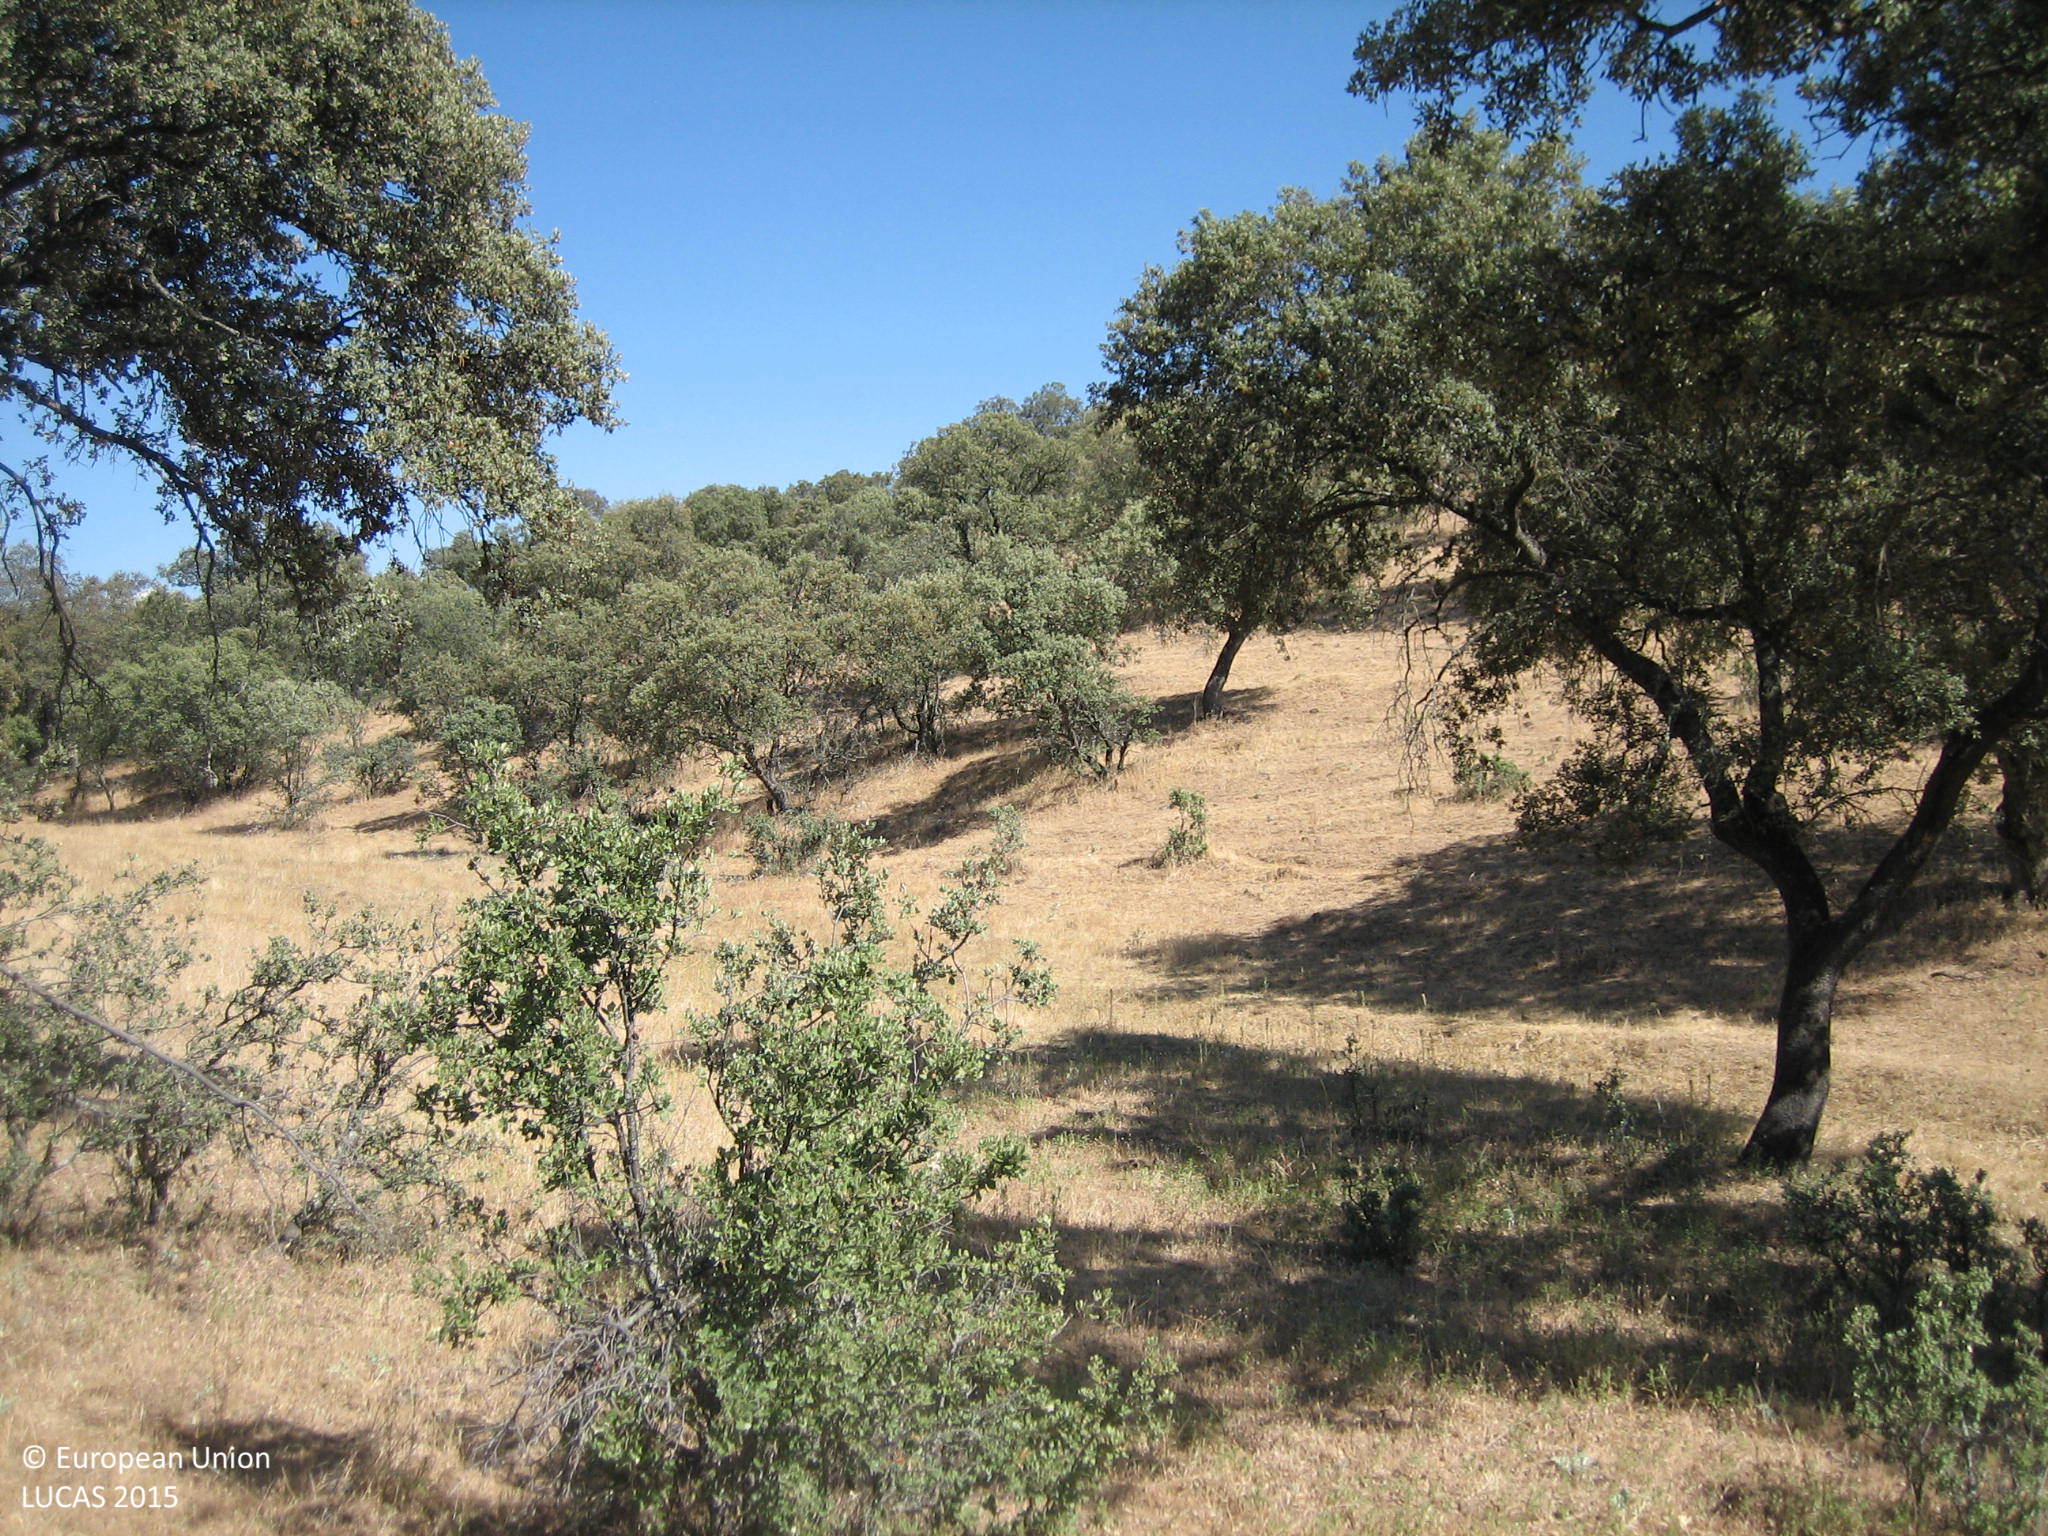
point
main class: Woodland
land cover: Broadleaved woodland
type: broadleaved evergreen forest
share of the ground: 10 - 25 %
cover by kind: herbaceous plants 85 %, broadleaved forest trees 15 %
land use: Forestry
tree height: > 5 m
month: May
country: ES
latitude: 38.5103
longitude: -3.9705
